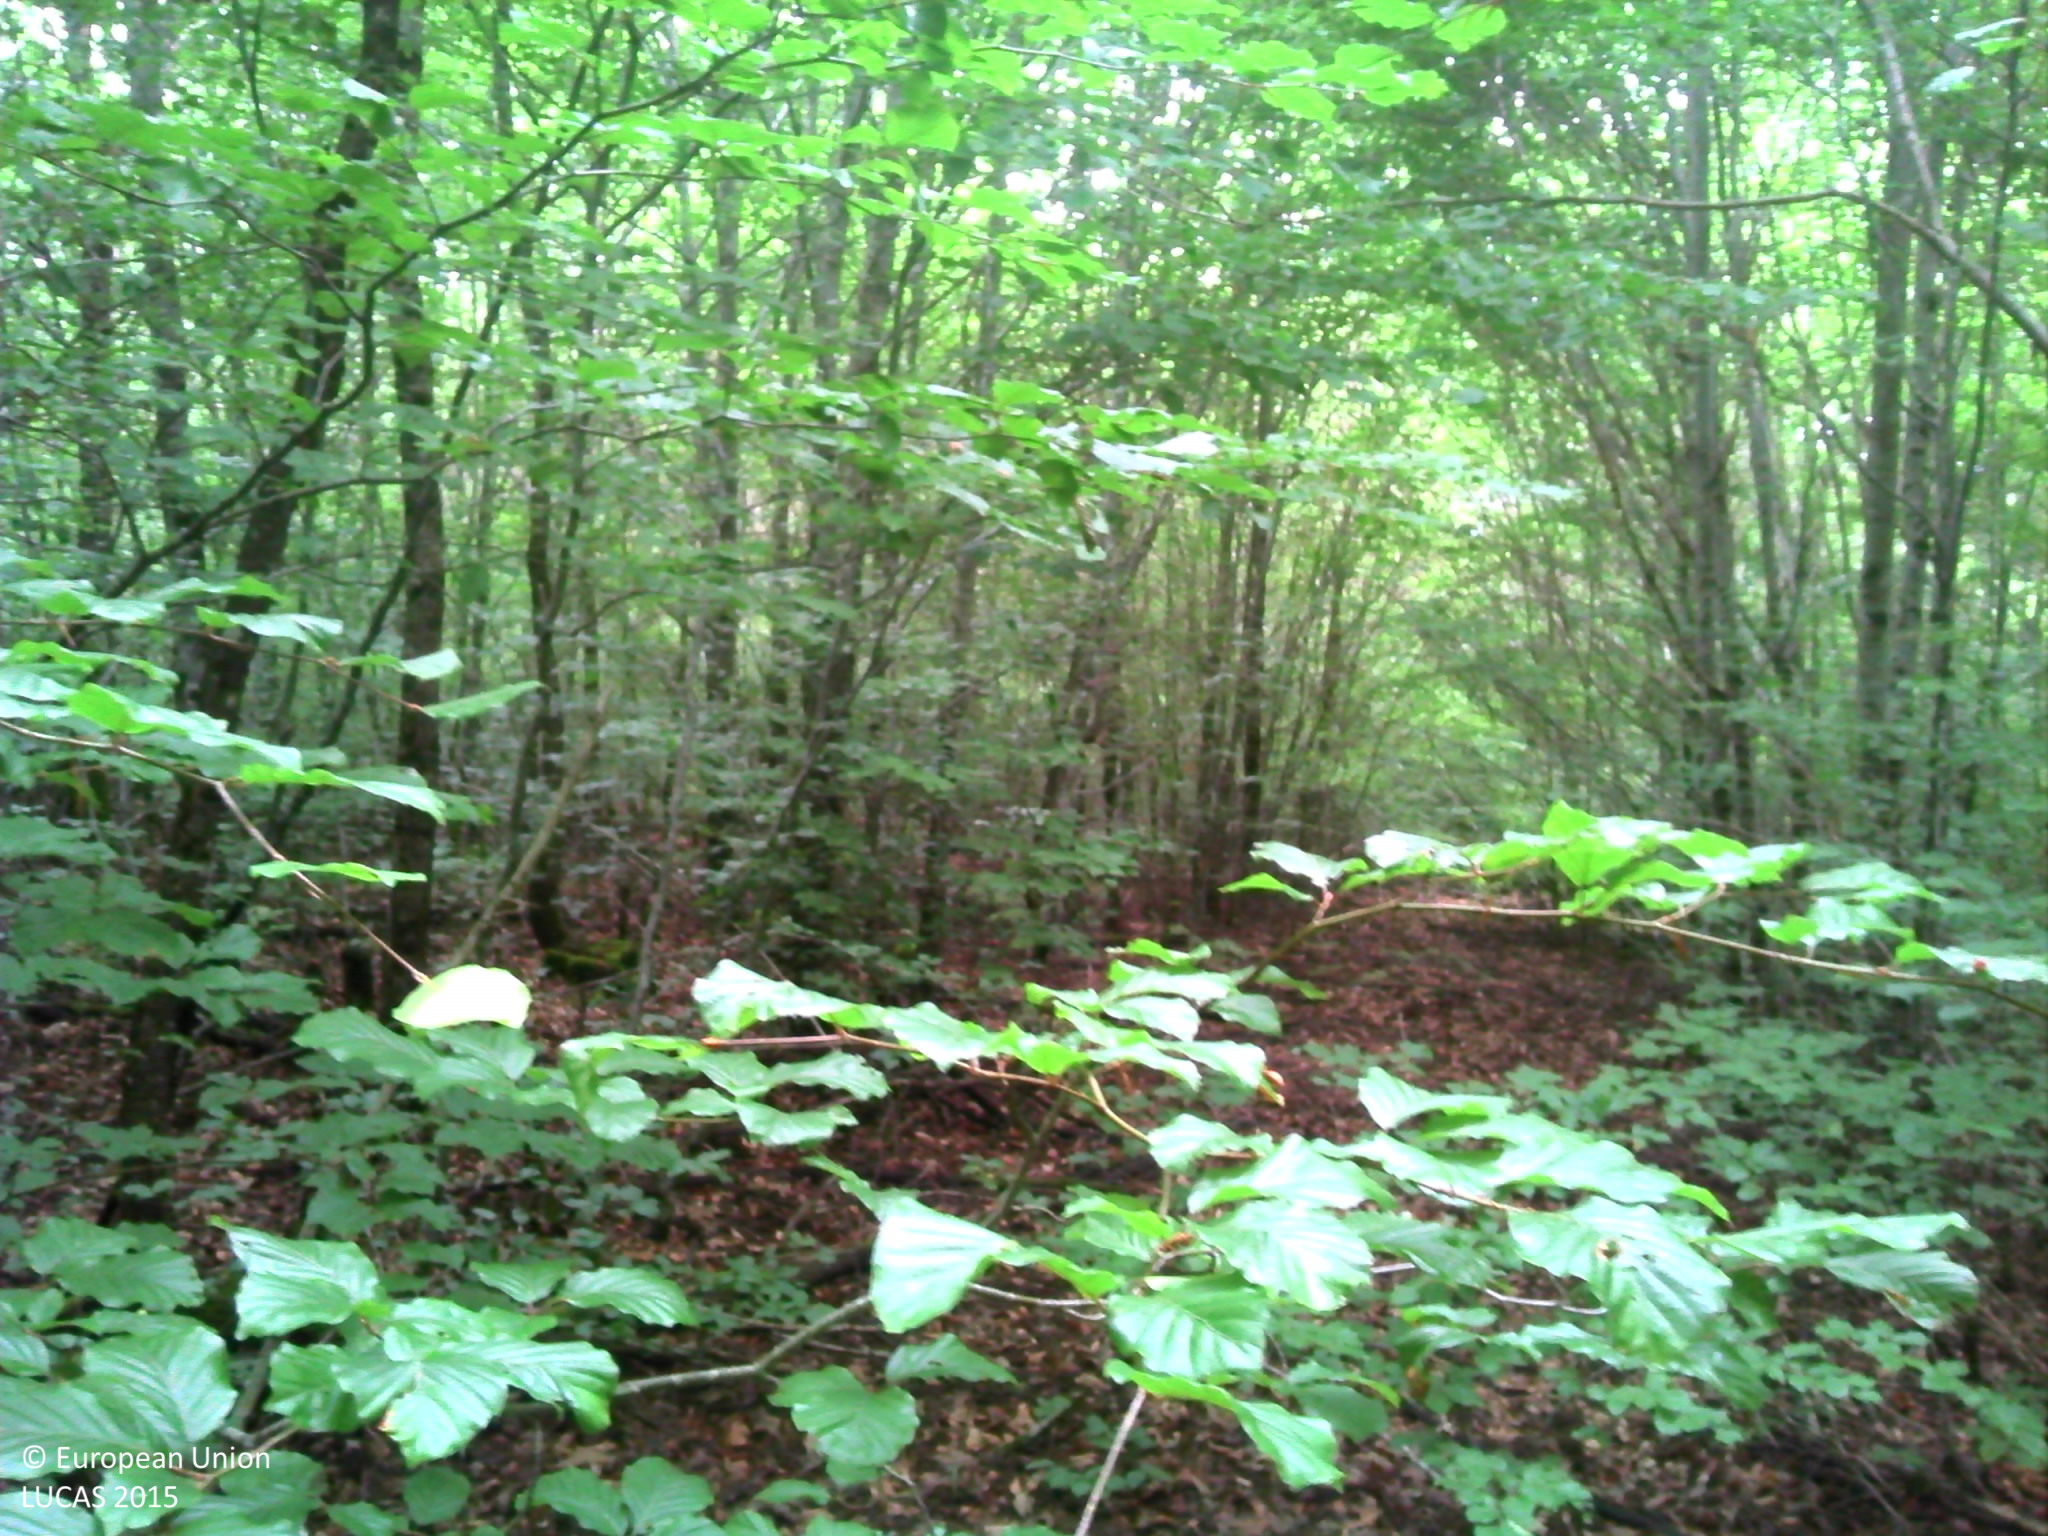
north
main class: Woodland
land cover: Broadleaved woodland
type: beech forest
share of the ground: > 75 %
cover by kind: broadleaved forest trees 90 %, unconsolidated bare surface 10 %
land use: Forestry
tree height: > 5 m
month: June
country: FR
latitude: 47.9109
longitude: 6.3483
